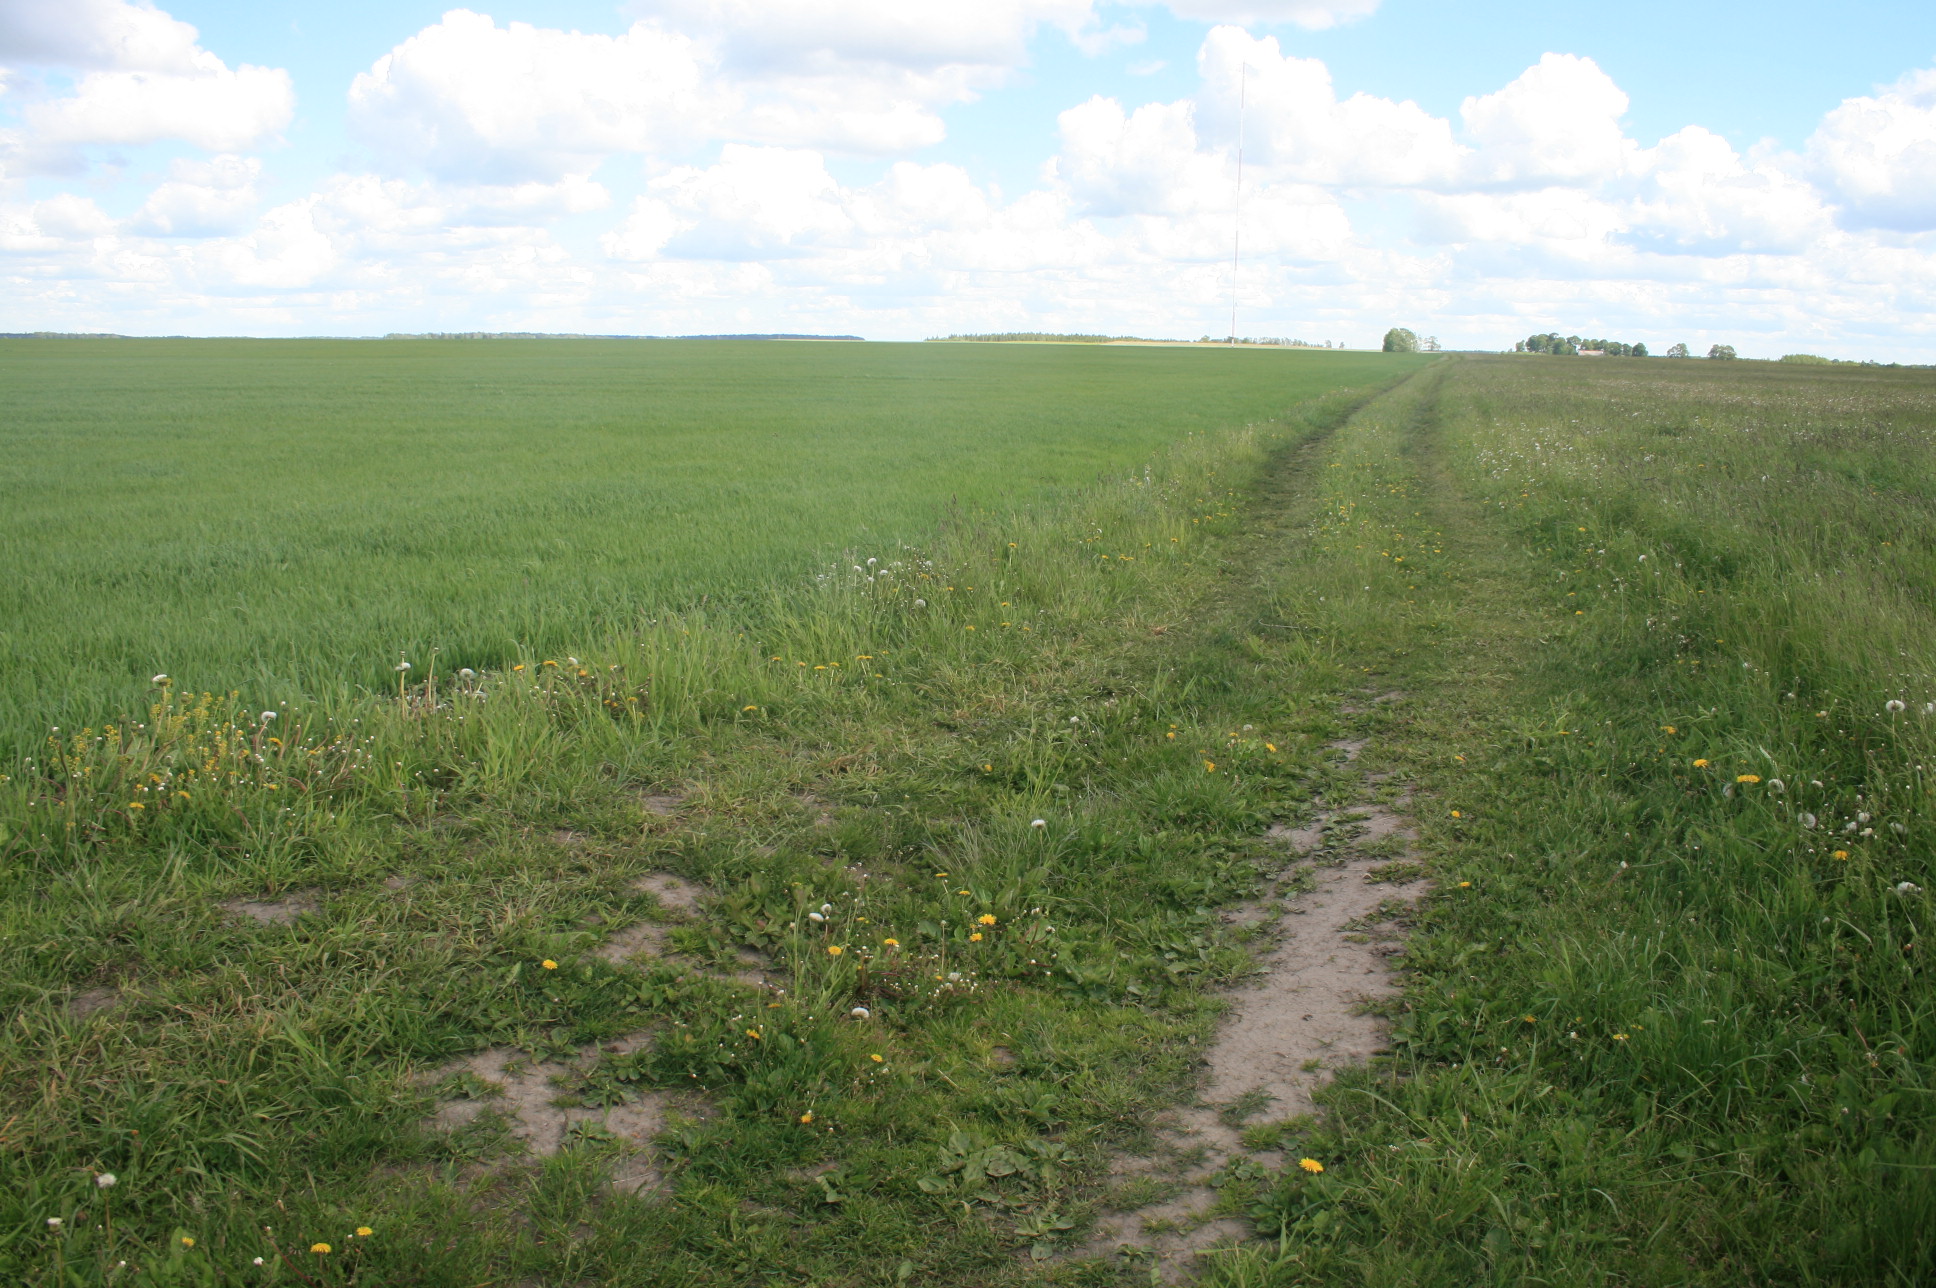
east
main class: Cropland
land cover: Oats
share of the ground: > 75 %
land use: Agriculture (excluding fallow land and kitchen gardens)
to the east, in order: Tracks; Oats
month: May
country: LT
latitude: 55.9888
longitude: 22.3520
